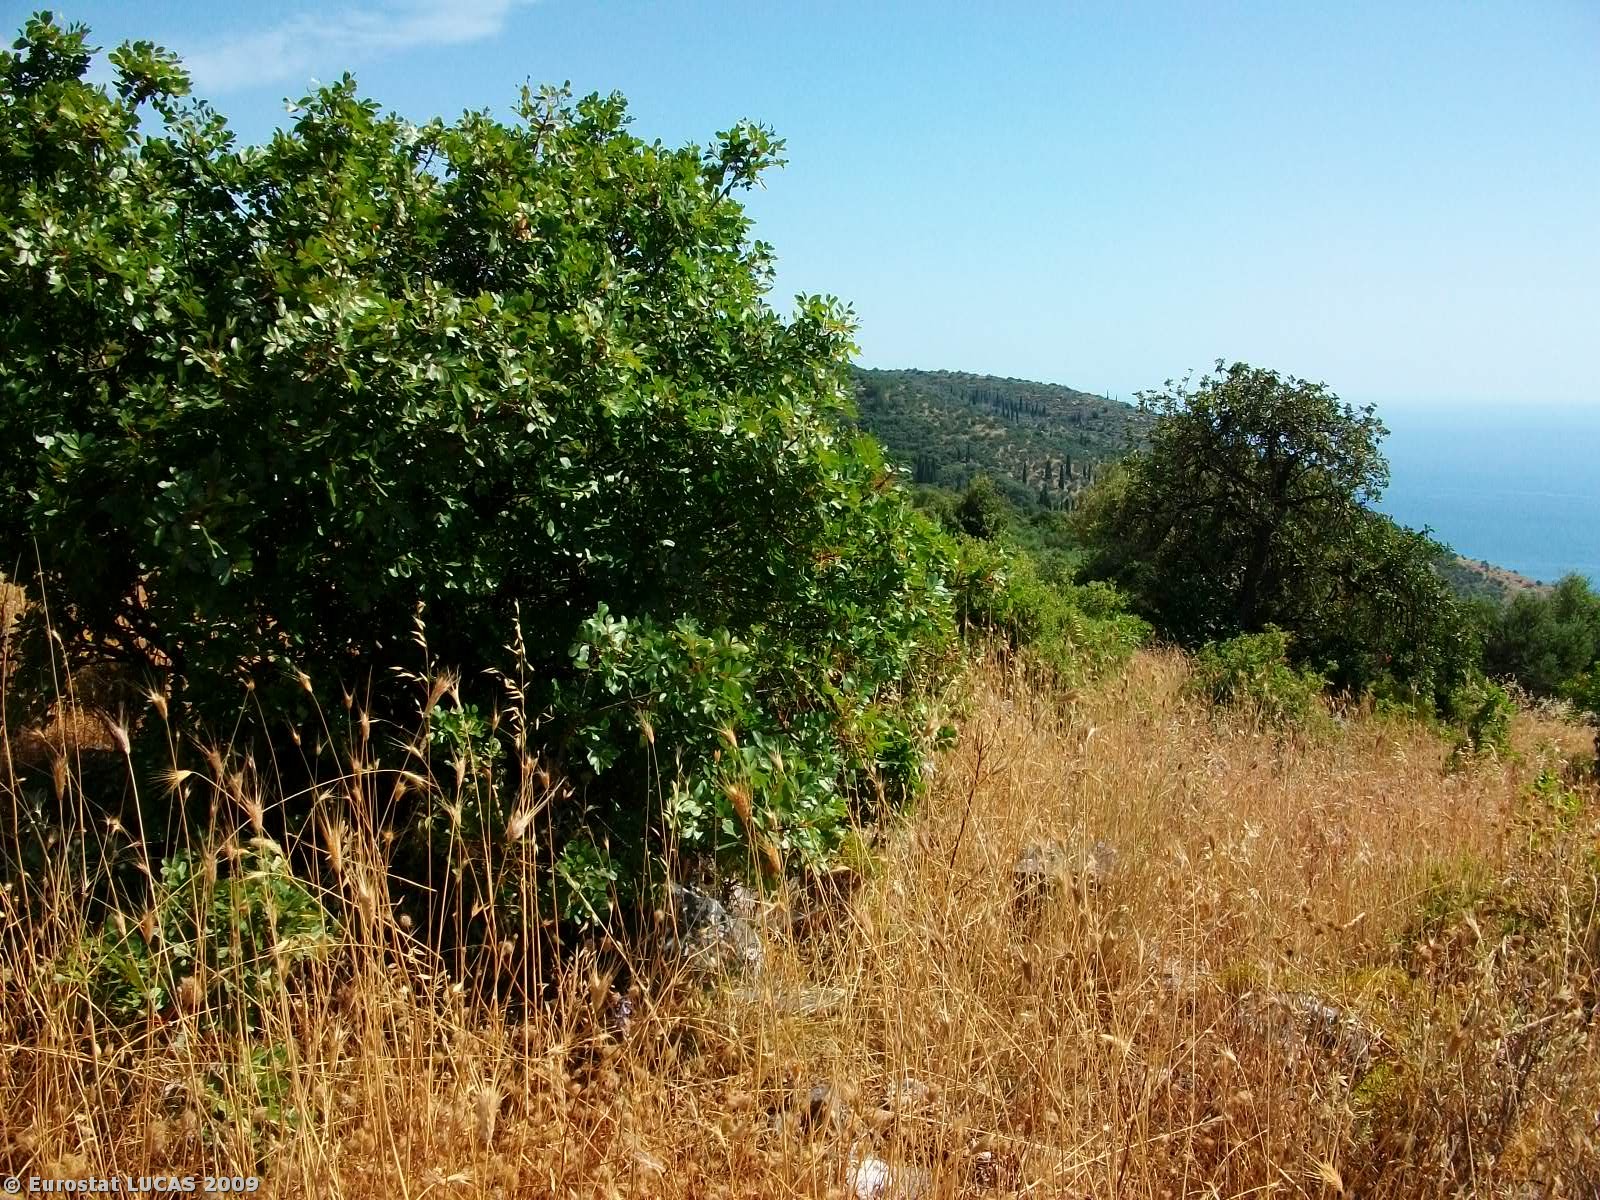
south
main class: Shrubland
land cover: Shrubland with sparse tree cover
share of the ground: > 75 %
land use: Unused
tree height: < 5 m
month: June
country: GR
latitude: 36.7974
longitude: 22.3129
